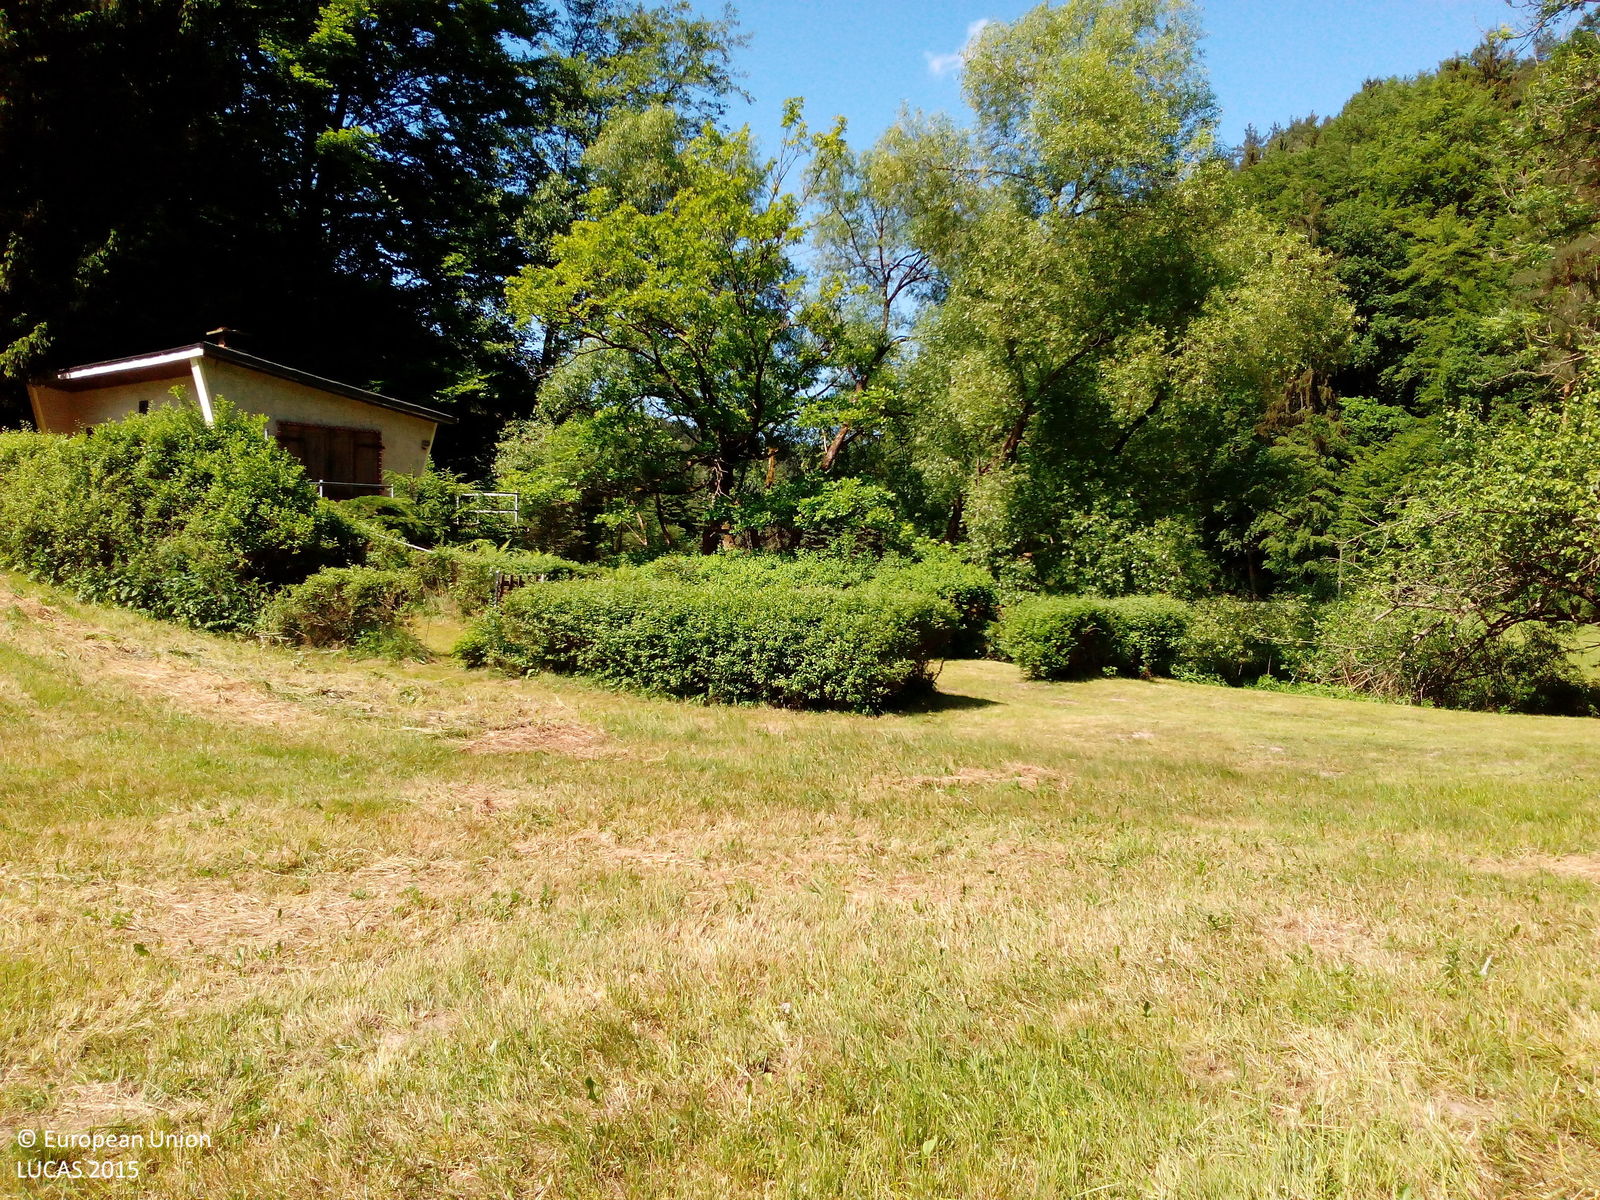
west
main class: Grassland
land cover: Grassland without tree/shrub cover
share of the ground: > 75 %
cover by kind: herbaceous plants 100 %
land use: Agriculture (excluding fallow land and kitchen gardens)
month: June
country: DE
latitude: 50.7844
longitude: 11.6024
